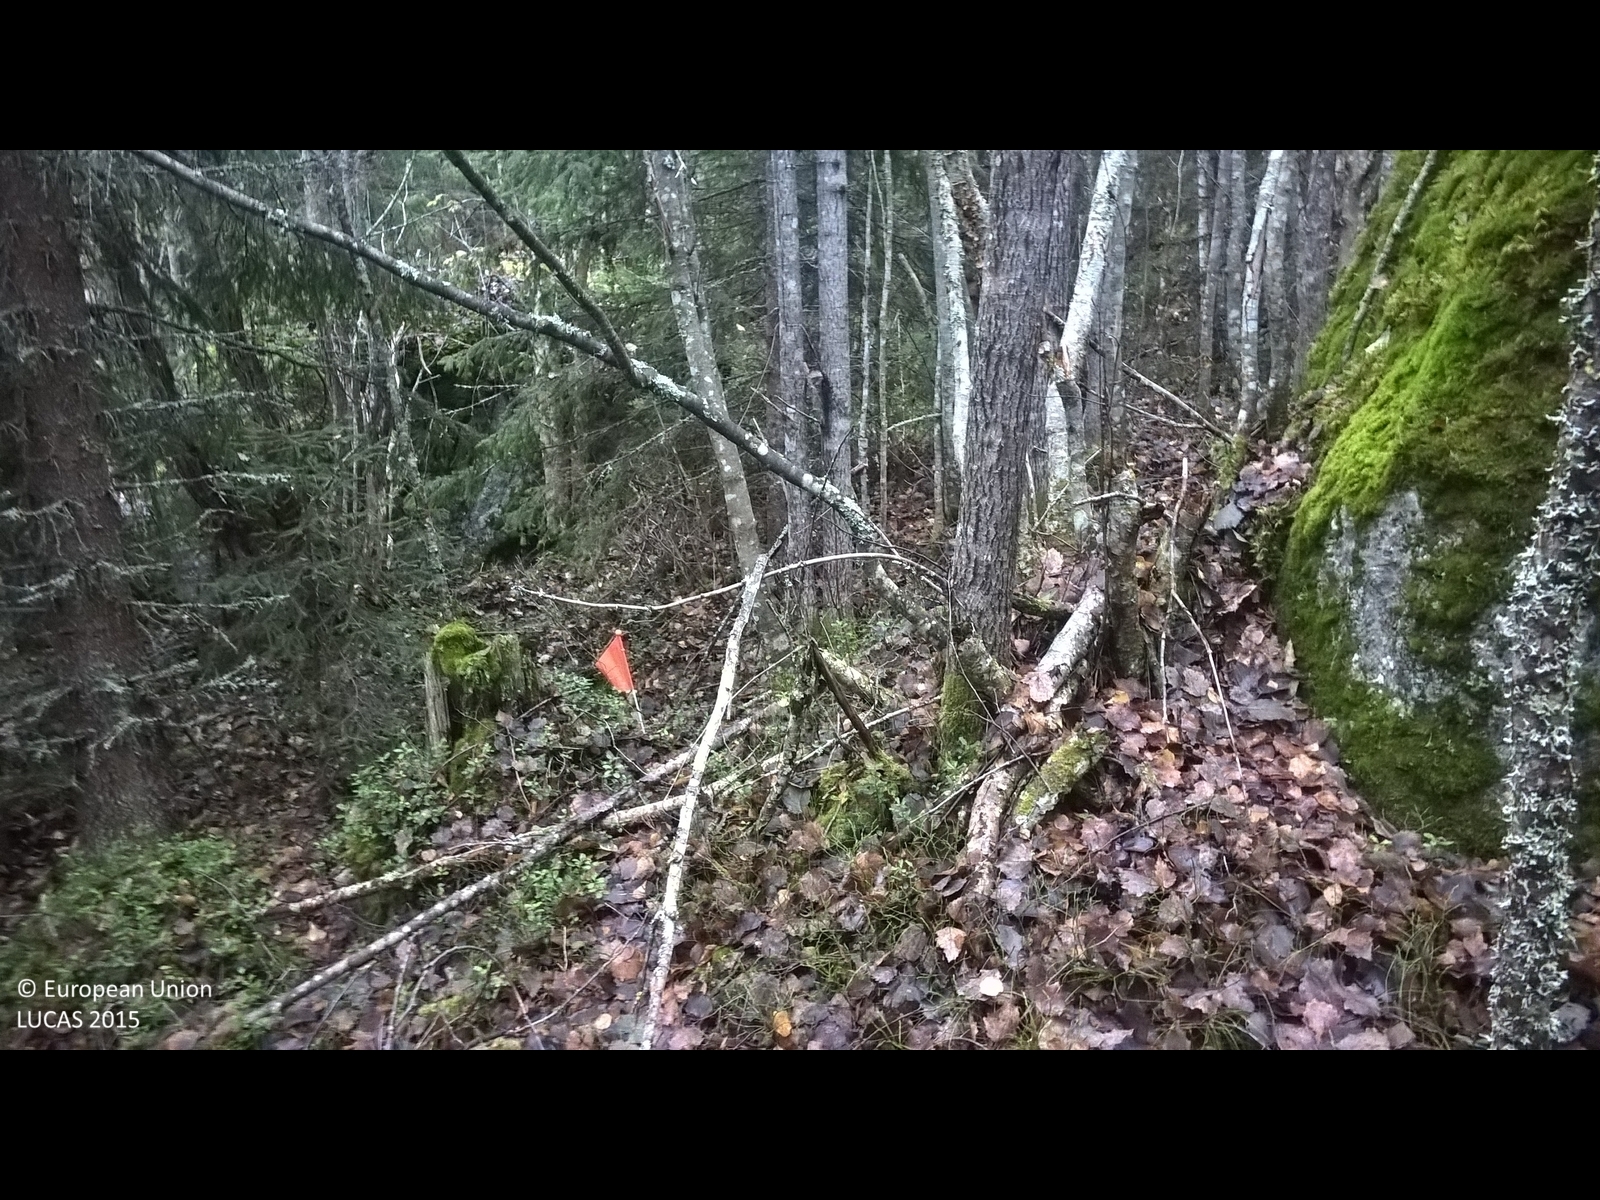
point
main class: Woodland
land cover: Spruce dominated mixed woodland
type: boreal forest
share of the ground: > 75 %
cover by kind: coniferous forest trees 40 %, broadleaved forest trees 40 %, lichens and mosses 20 %
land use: Forestry
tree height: > 5 m
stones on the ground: 10 - 25 %
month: October
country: SE
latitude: 62.8480
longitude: 16.1646
